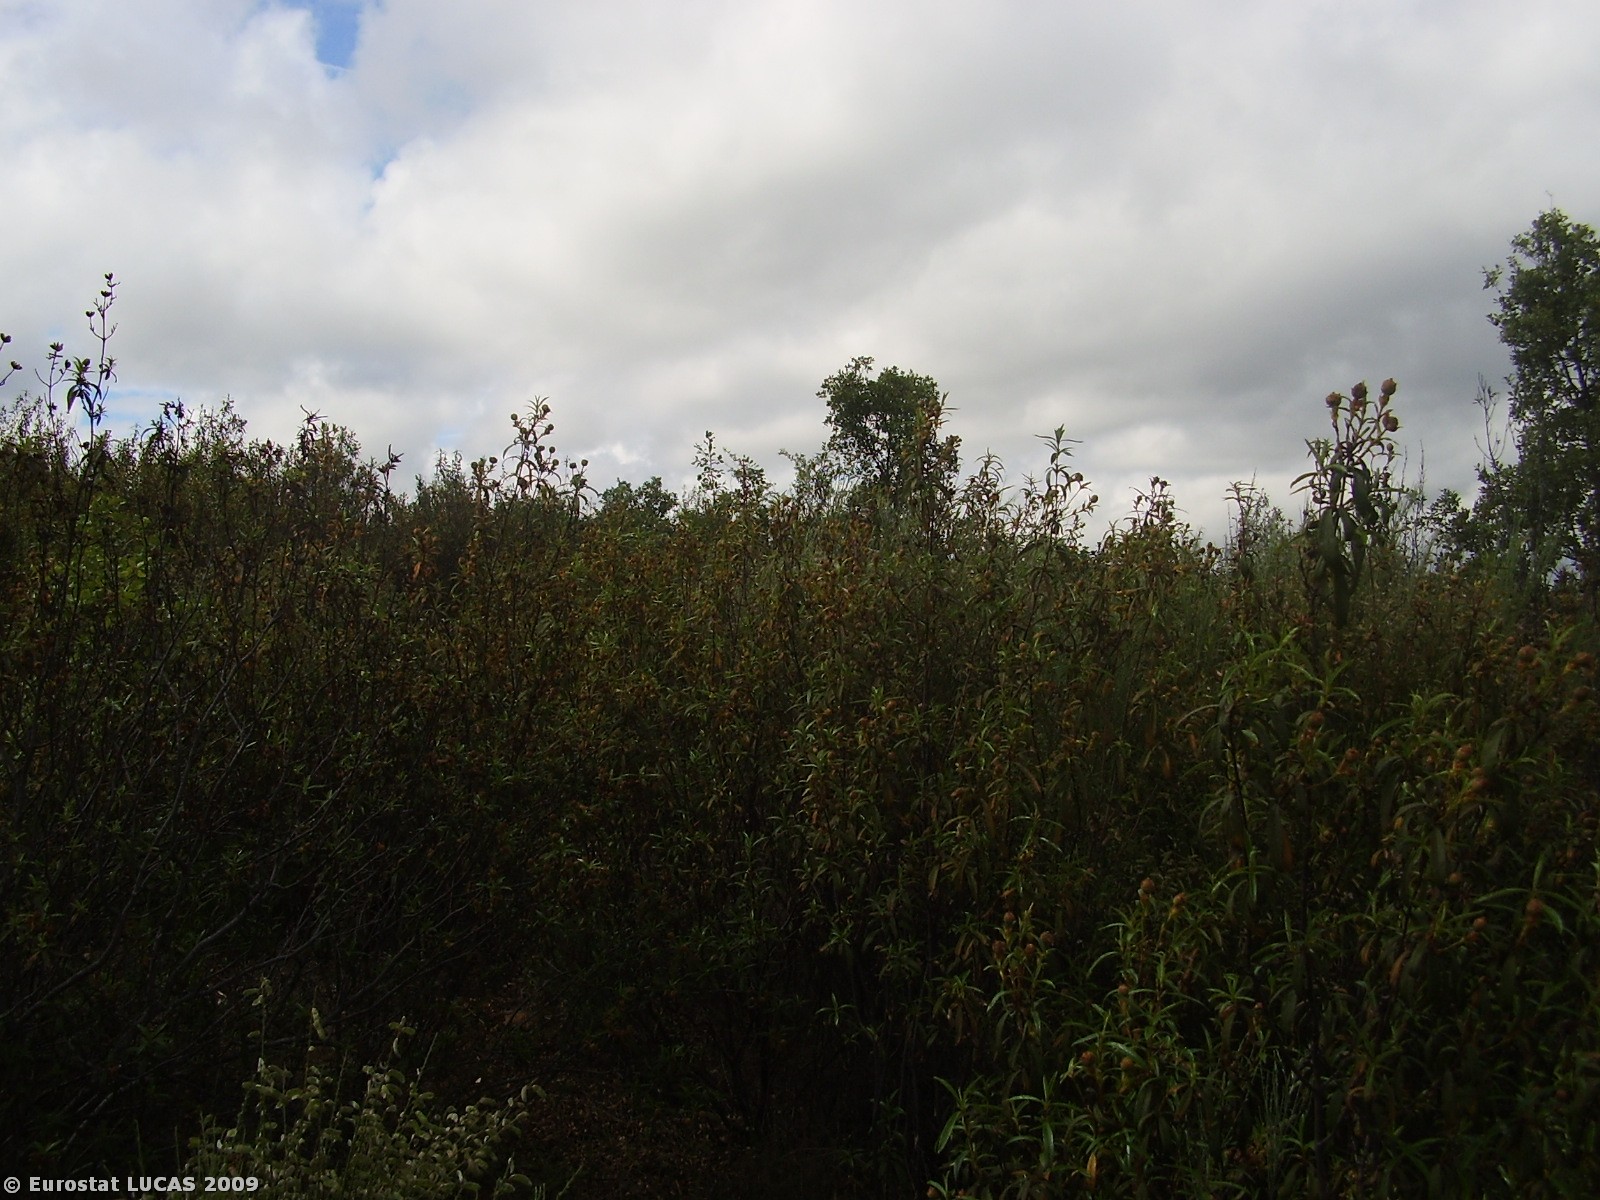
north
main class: Shrubland
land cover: Shrubland with sparse tree cover
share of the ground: > 75 %
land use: Nature reserves
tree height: > 5 m
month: June
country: PT
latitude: 41.5460
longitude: -6.8344
